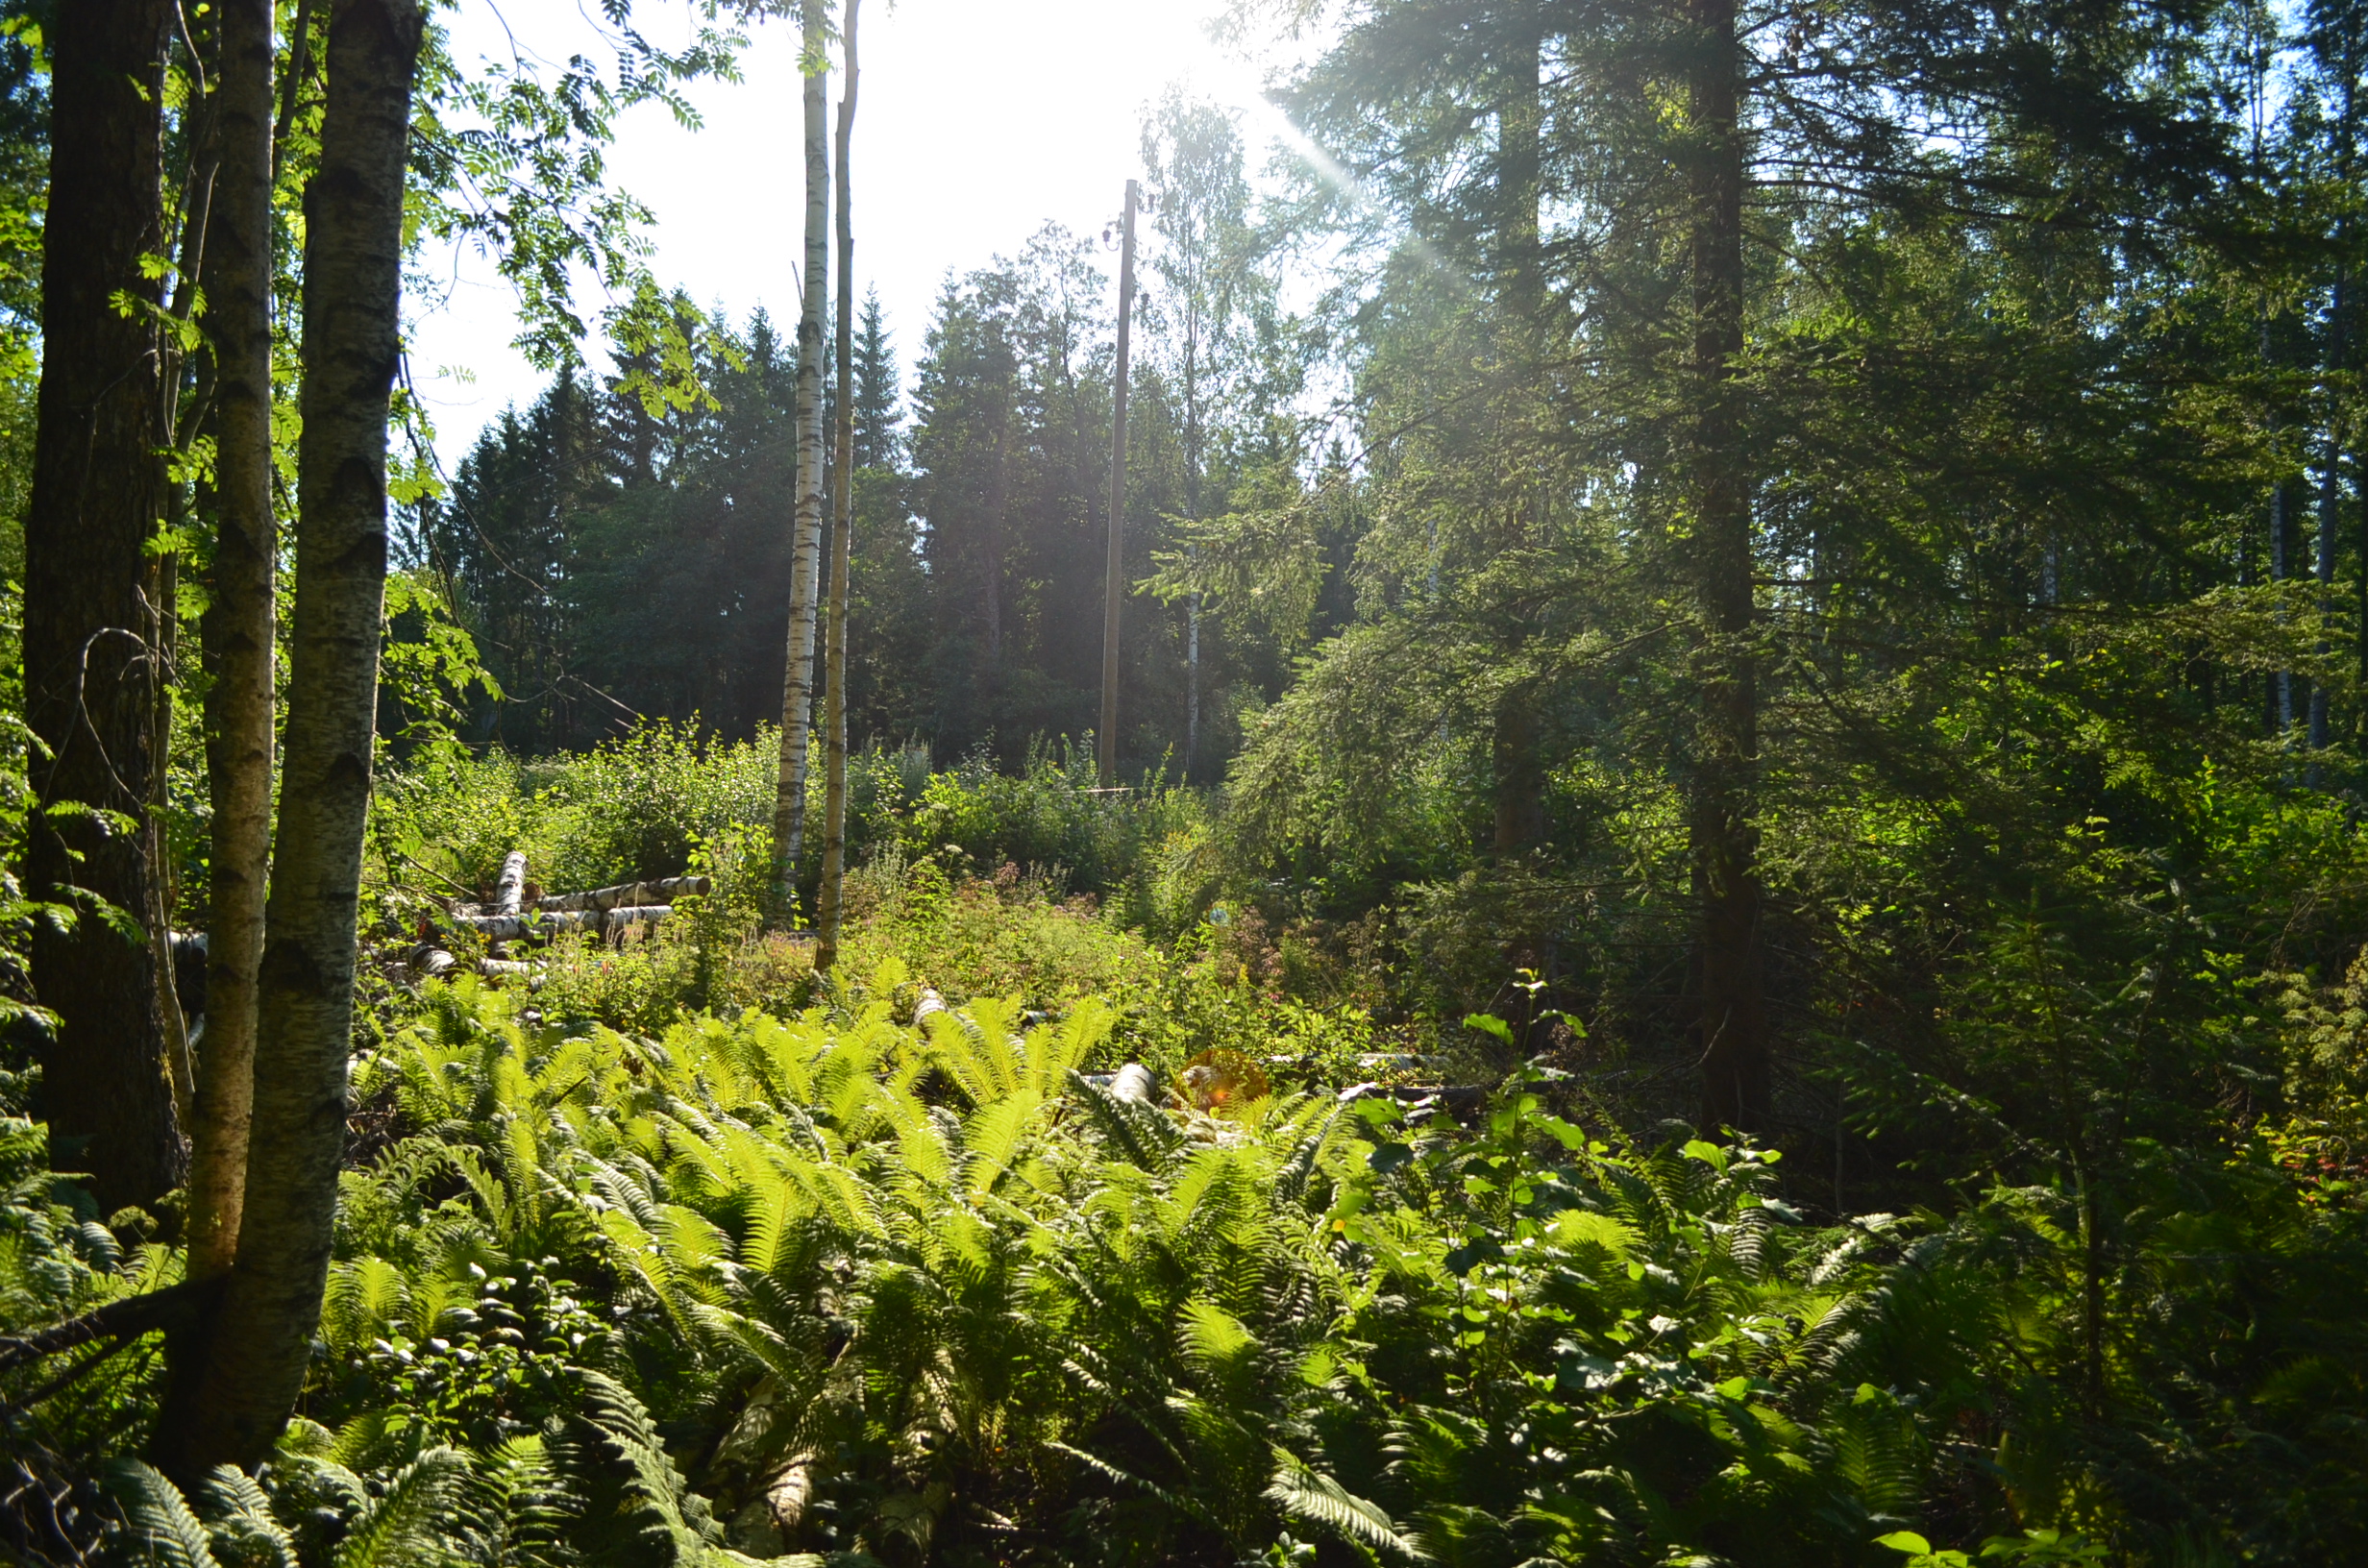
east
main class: Woodland
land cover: Spruce dominated mixed woodland
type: hemiboreal forest and nemoral coniferous forest and mixed broadleaved-coniferous forest
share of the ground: 50 - 75 %
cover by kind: broadleaved forest trees 30 %, coniferous forest trees 25 %, herbaceous plants 25 %, shrubs 20 %
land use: Forestry
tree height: > 5 m
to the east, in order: Spruce dominated mixed woodland; Ditches and canals; Electric lines; Shruby margins; Paved roads, cycling and walking lanes; Grass margins; Ditches and canals; Paved roads, cycling and walking lanes; Shruby margins; Ditches and canals; Spruce dominated coniferous woodland; Broadleaved woodland
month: August
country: LV
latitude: 57.6198
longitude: 22.2533
